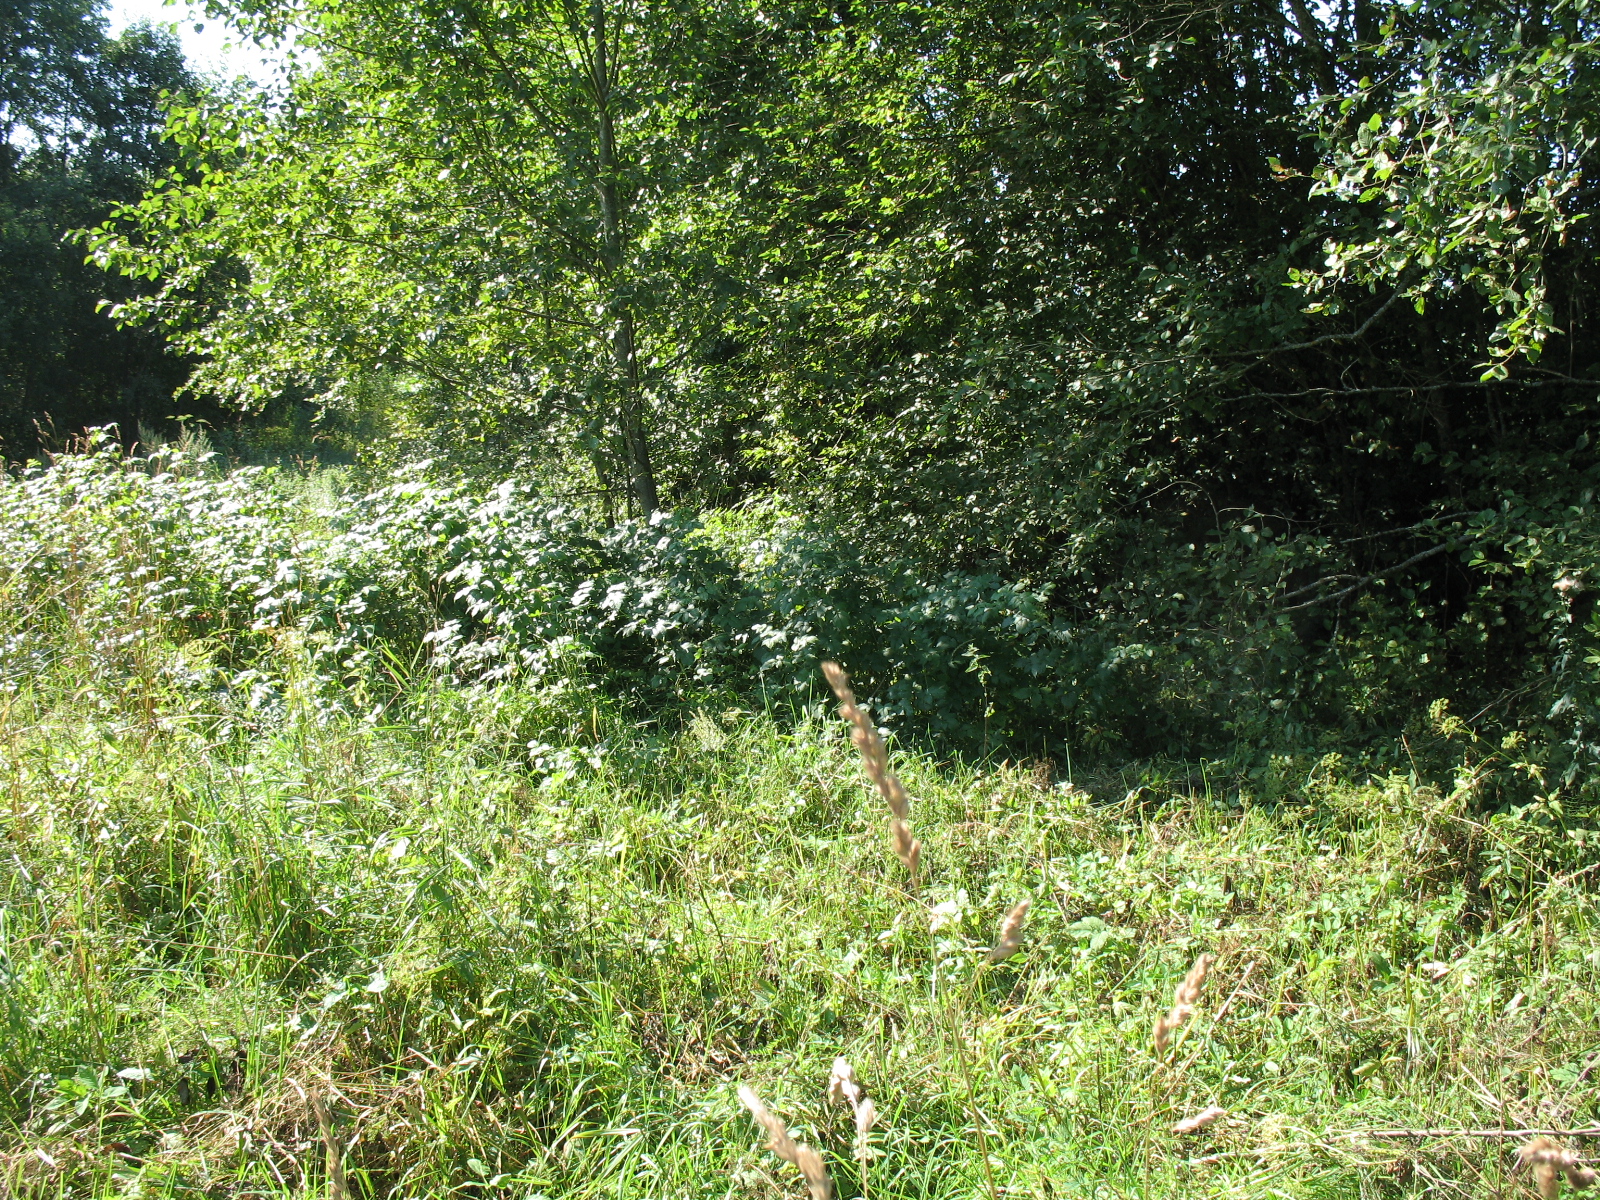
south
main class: Grassland
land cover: Spontaneously vegetated surfaces
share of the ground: > 75 %
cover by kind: herbaceous plants 95 %, shrubs 5 %
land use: Semi-natural and natural areas not in use
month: August
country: LV
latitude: 56.2369
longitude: 25.4305
